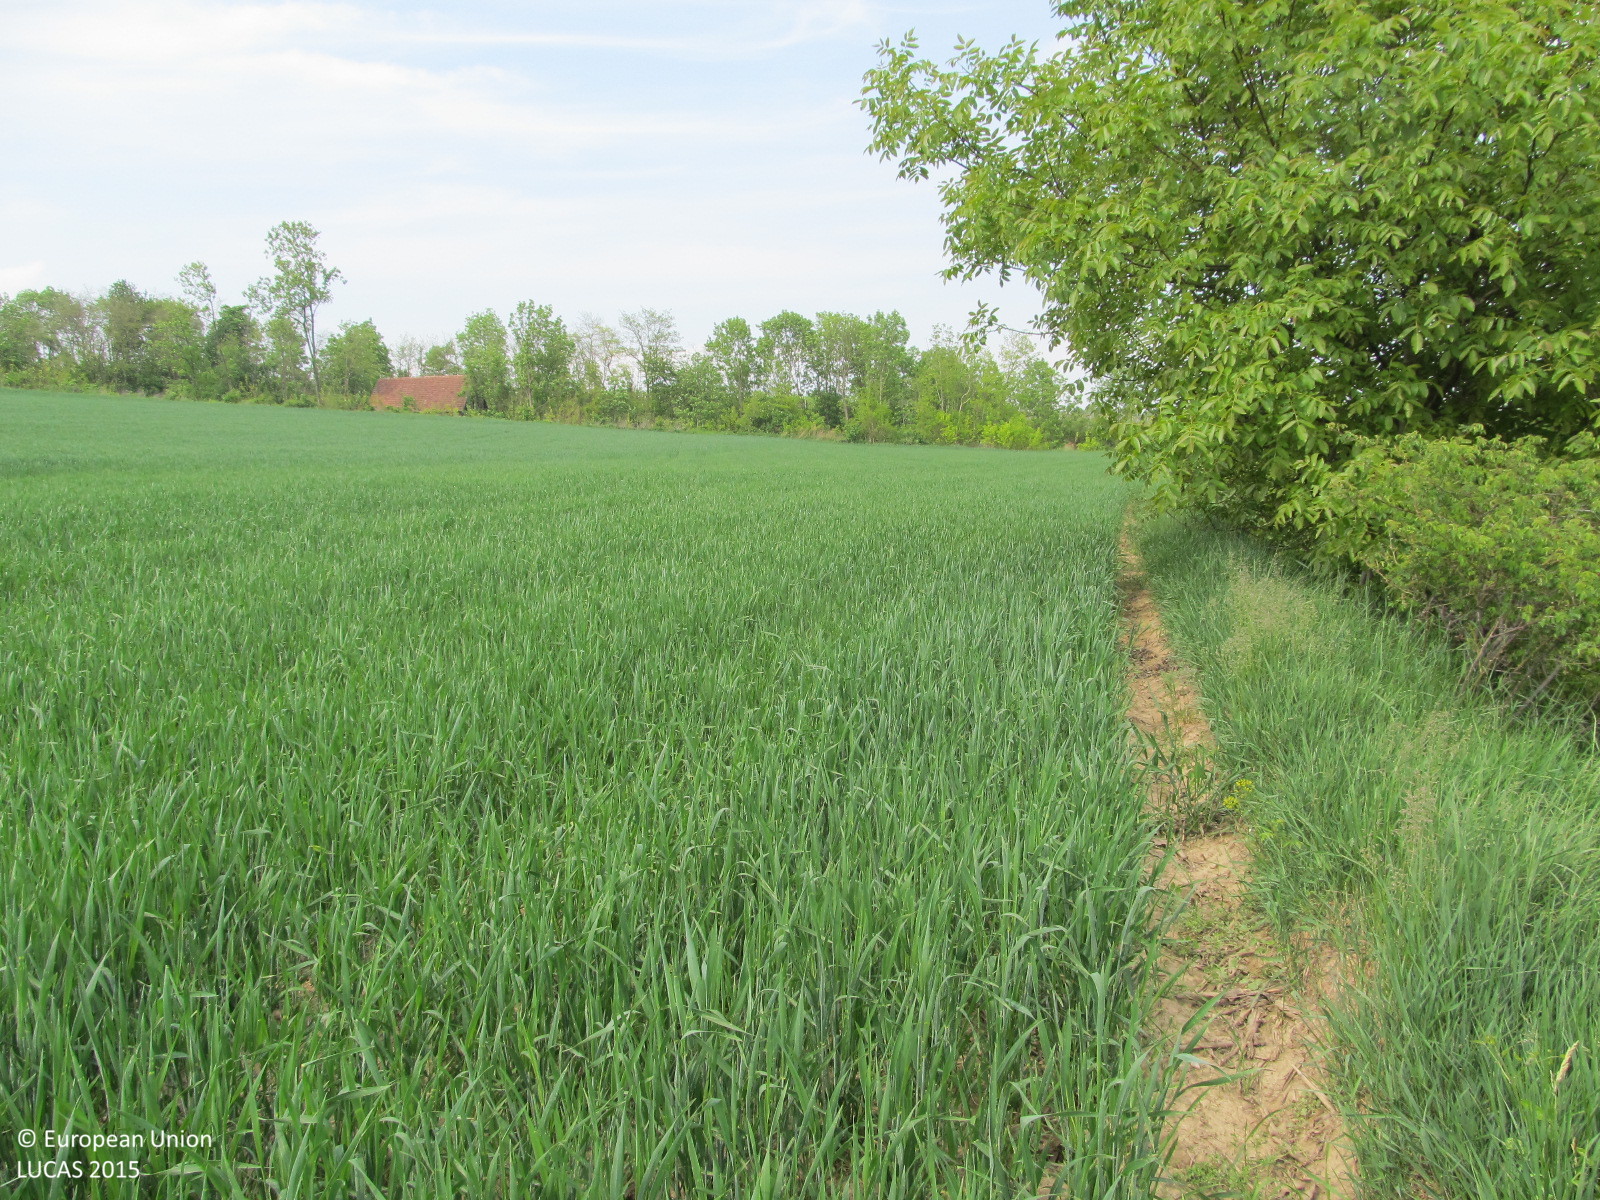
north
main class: Cropland
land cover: Vineyards
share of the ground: 25 - 50 %
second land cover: Grassland without tree/shrub cover
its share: 25 - 50 %
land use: Agriculture (excluding fallow land and kitchen gardens)
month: May
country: AT
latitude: 48.4674
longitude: 15.8058
